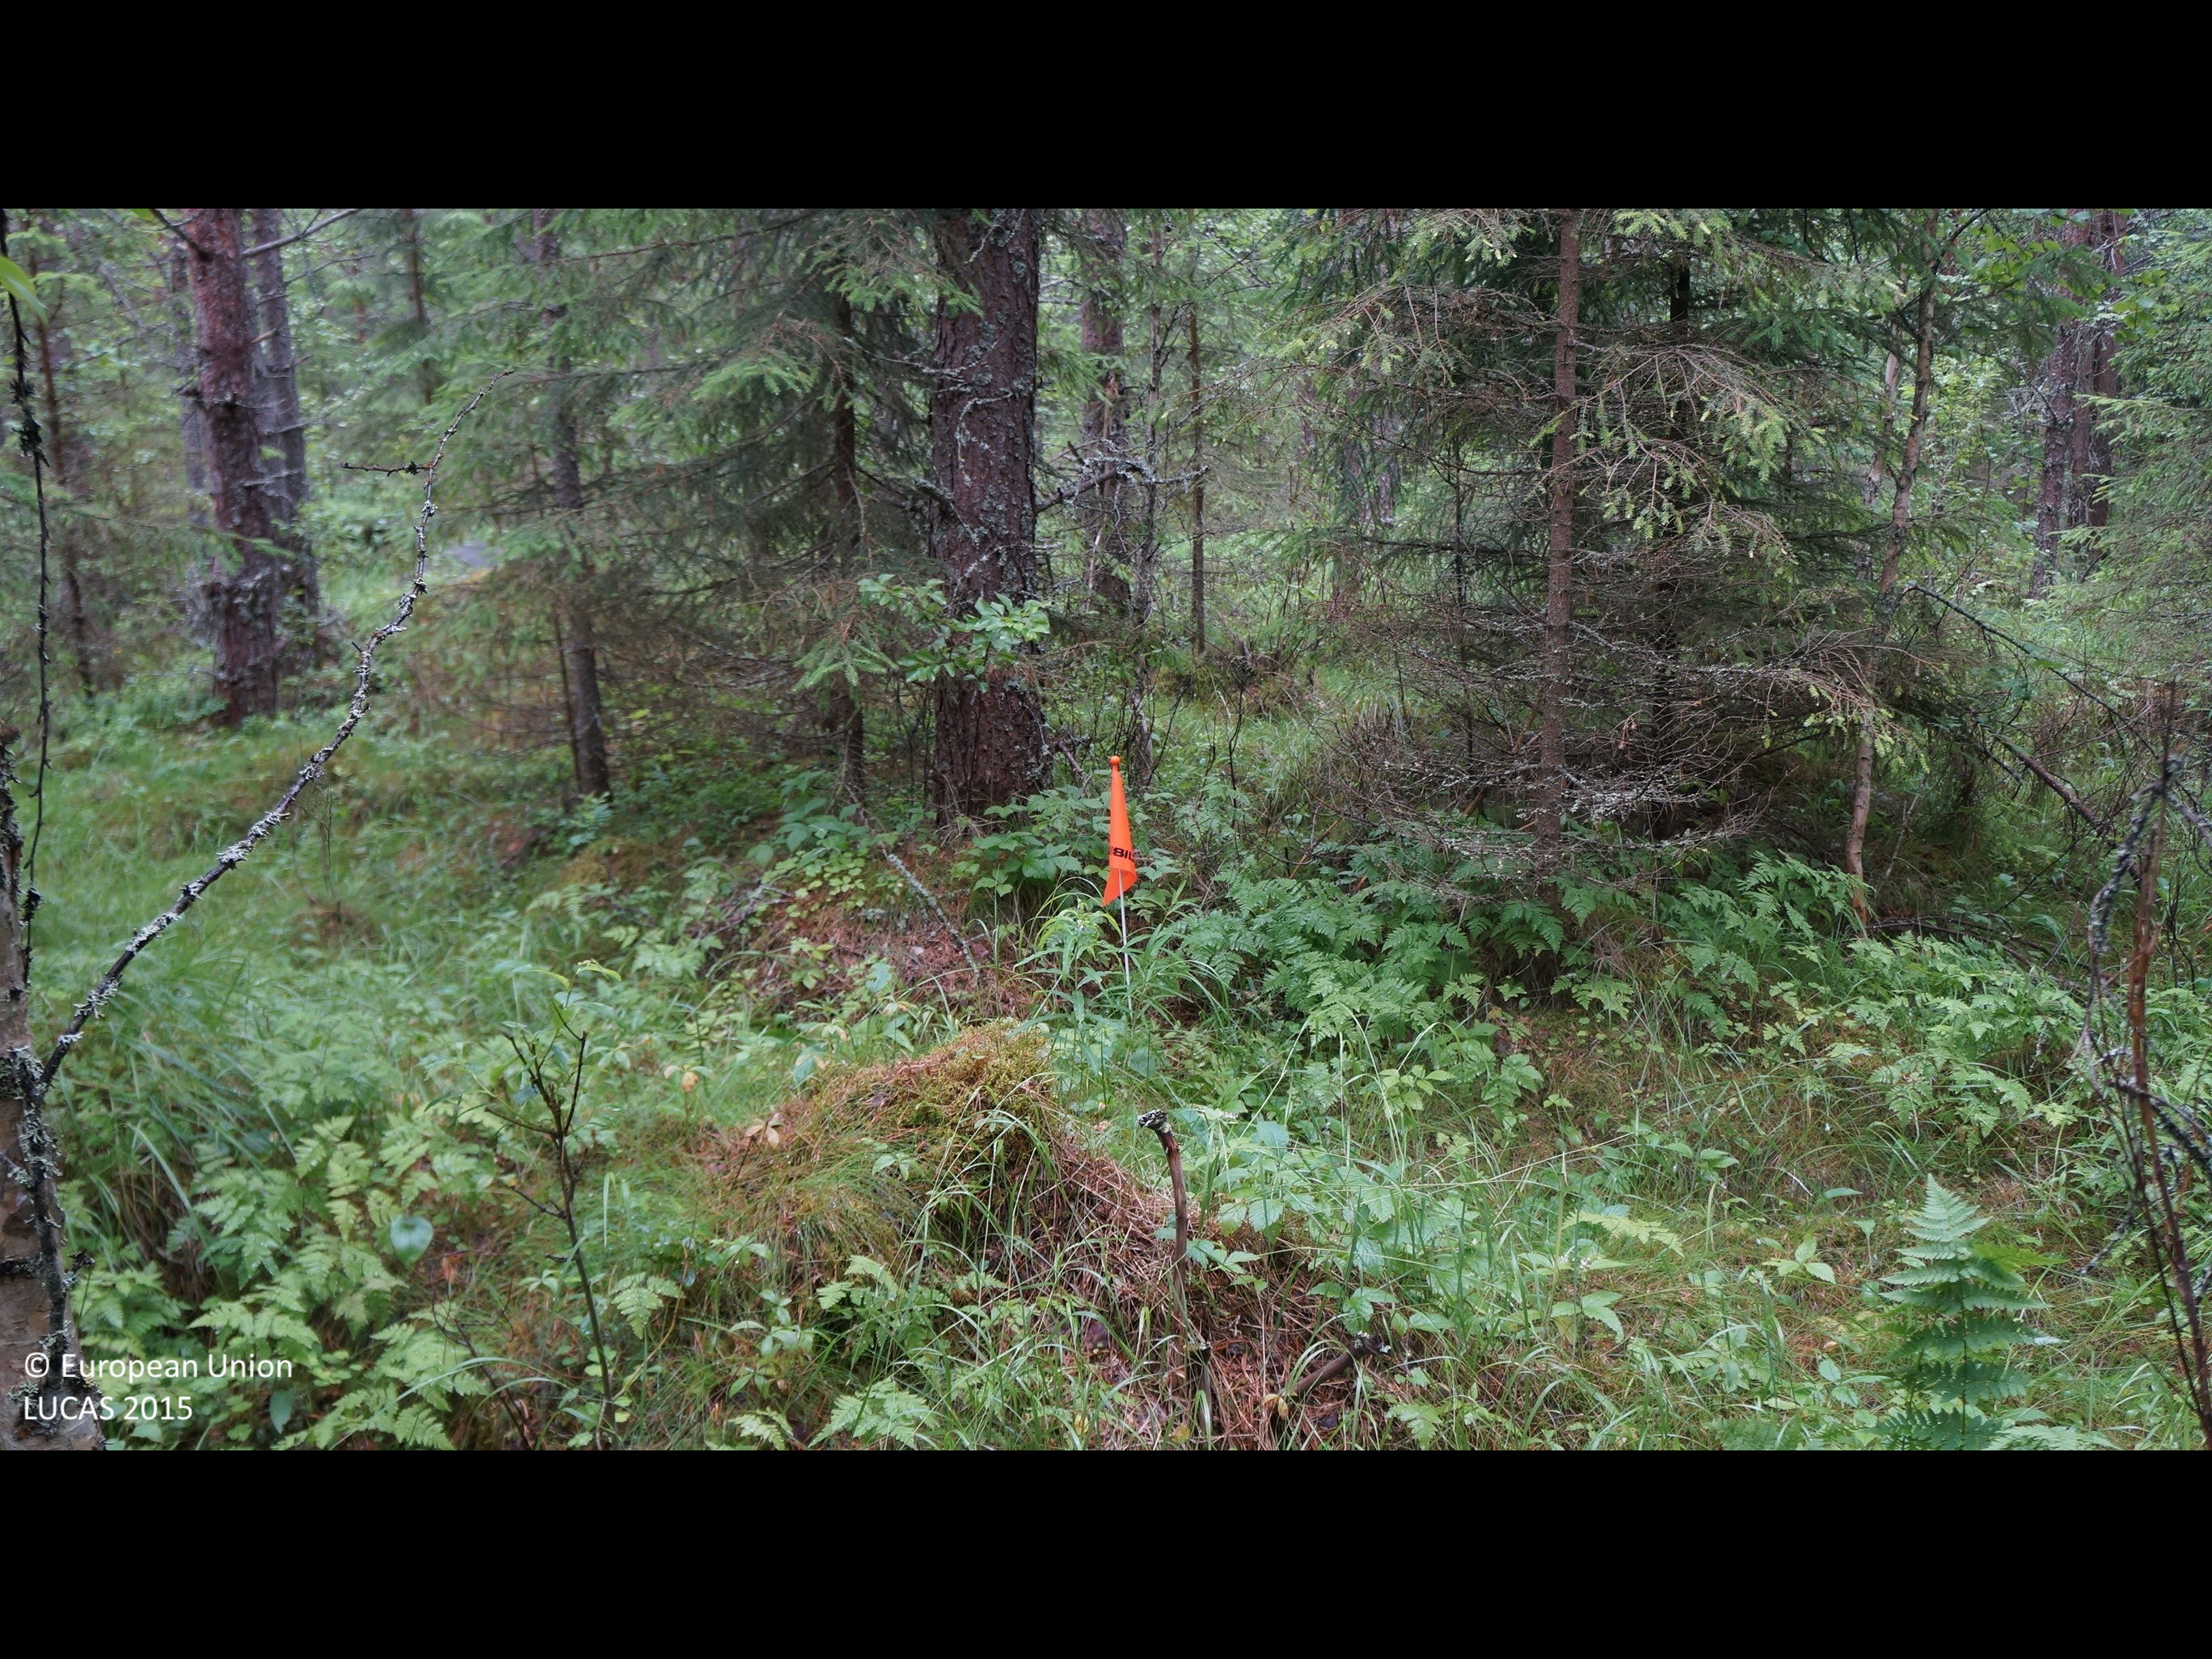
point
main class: Woodland
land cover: Pine dominated mixed woodland
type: boreal forest
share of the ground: > 75 %
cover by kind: coniferous forest trees 55 %, broadleaved forest trees 20 %, herbaceous plants 15 %, shrubs 10 %
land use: Forestry
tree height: > 5 m
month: July
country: FI
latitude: 64.4152
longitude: 24.8329
